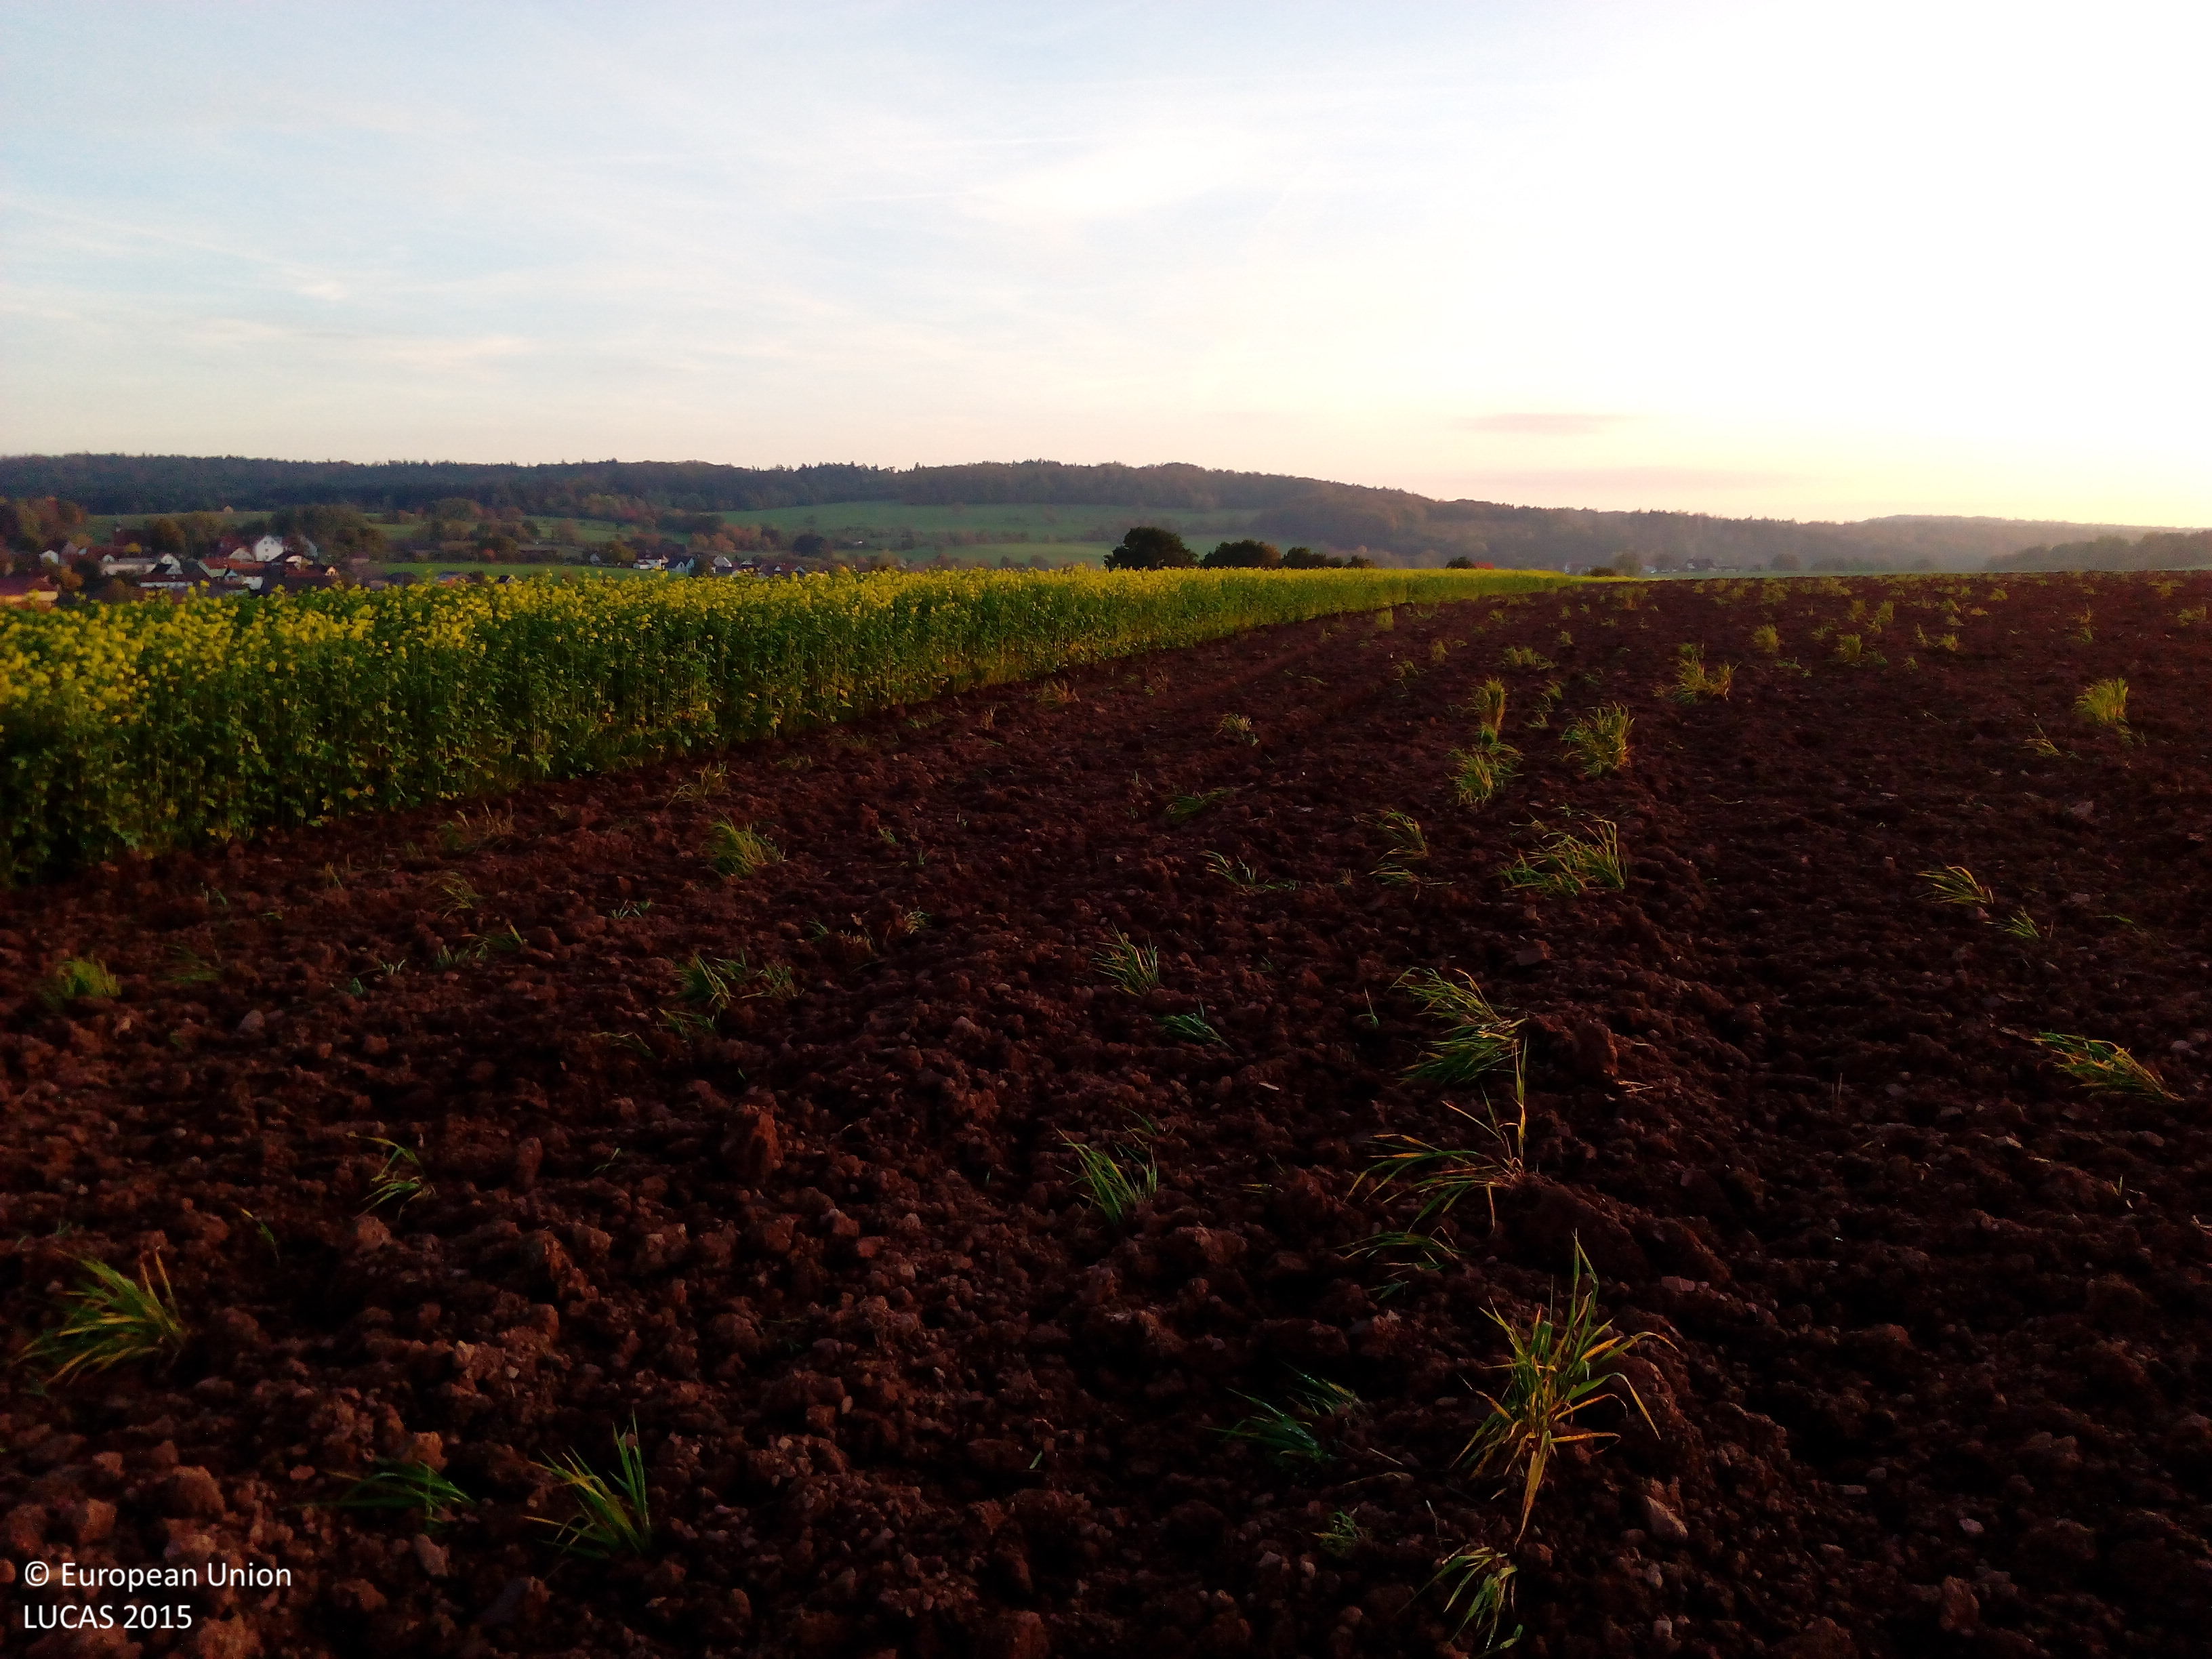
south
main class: Cropland
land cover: Barley
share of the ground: < 10 %
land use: Agriculture (excluding fallow land and kitchen gardens)
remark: Tilled/Sowed
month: October
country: DE
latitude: 50.2561
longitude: 9.8458
